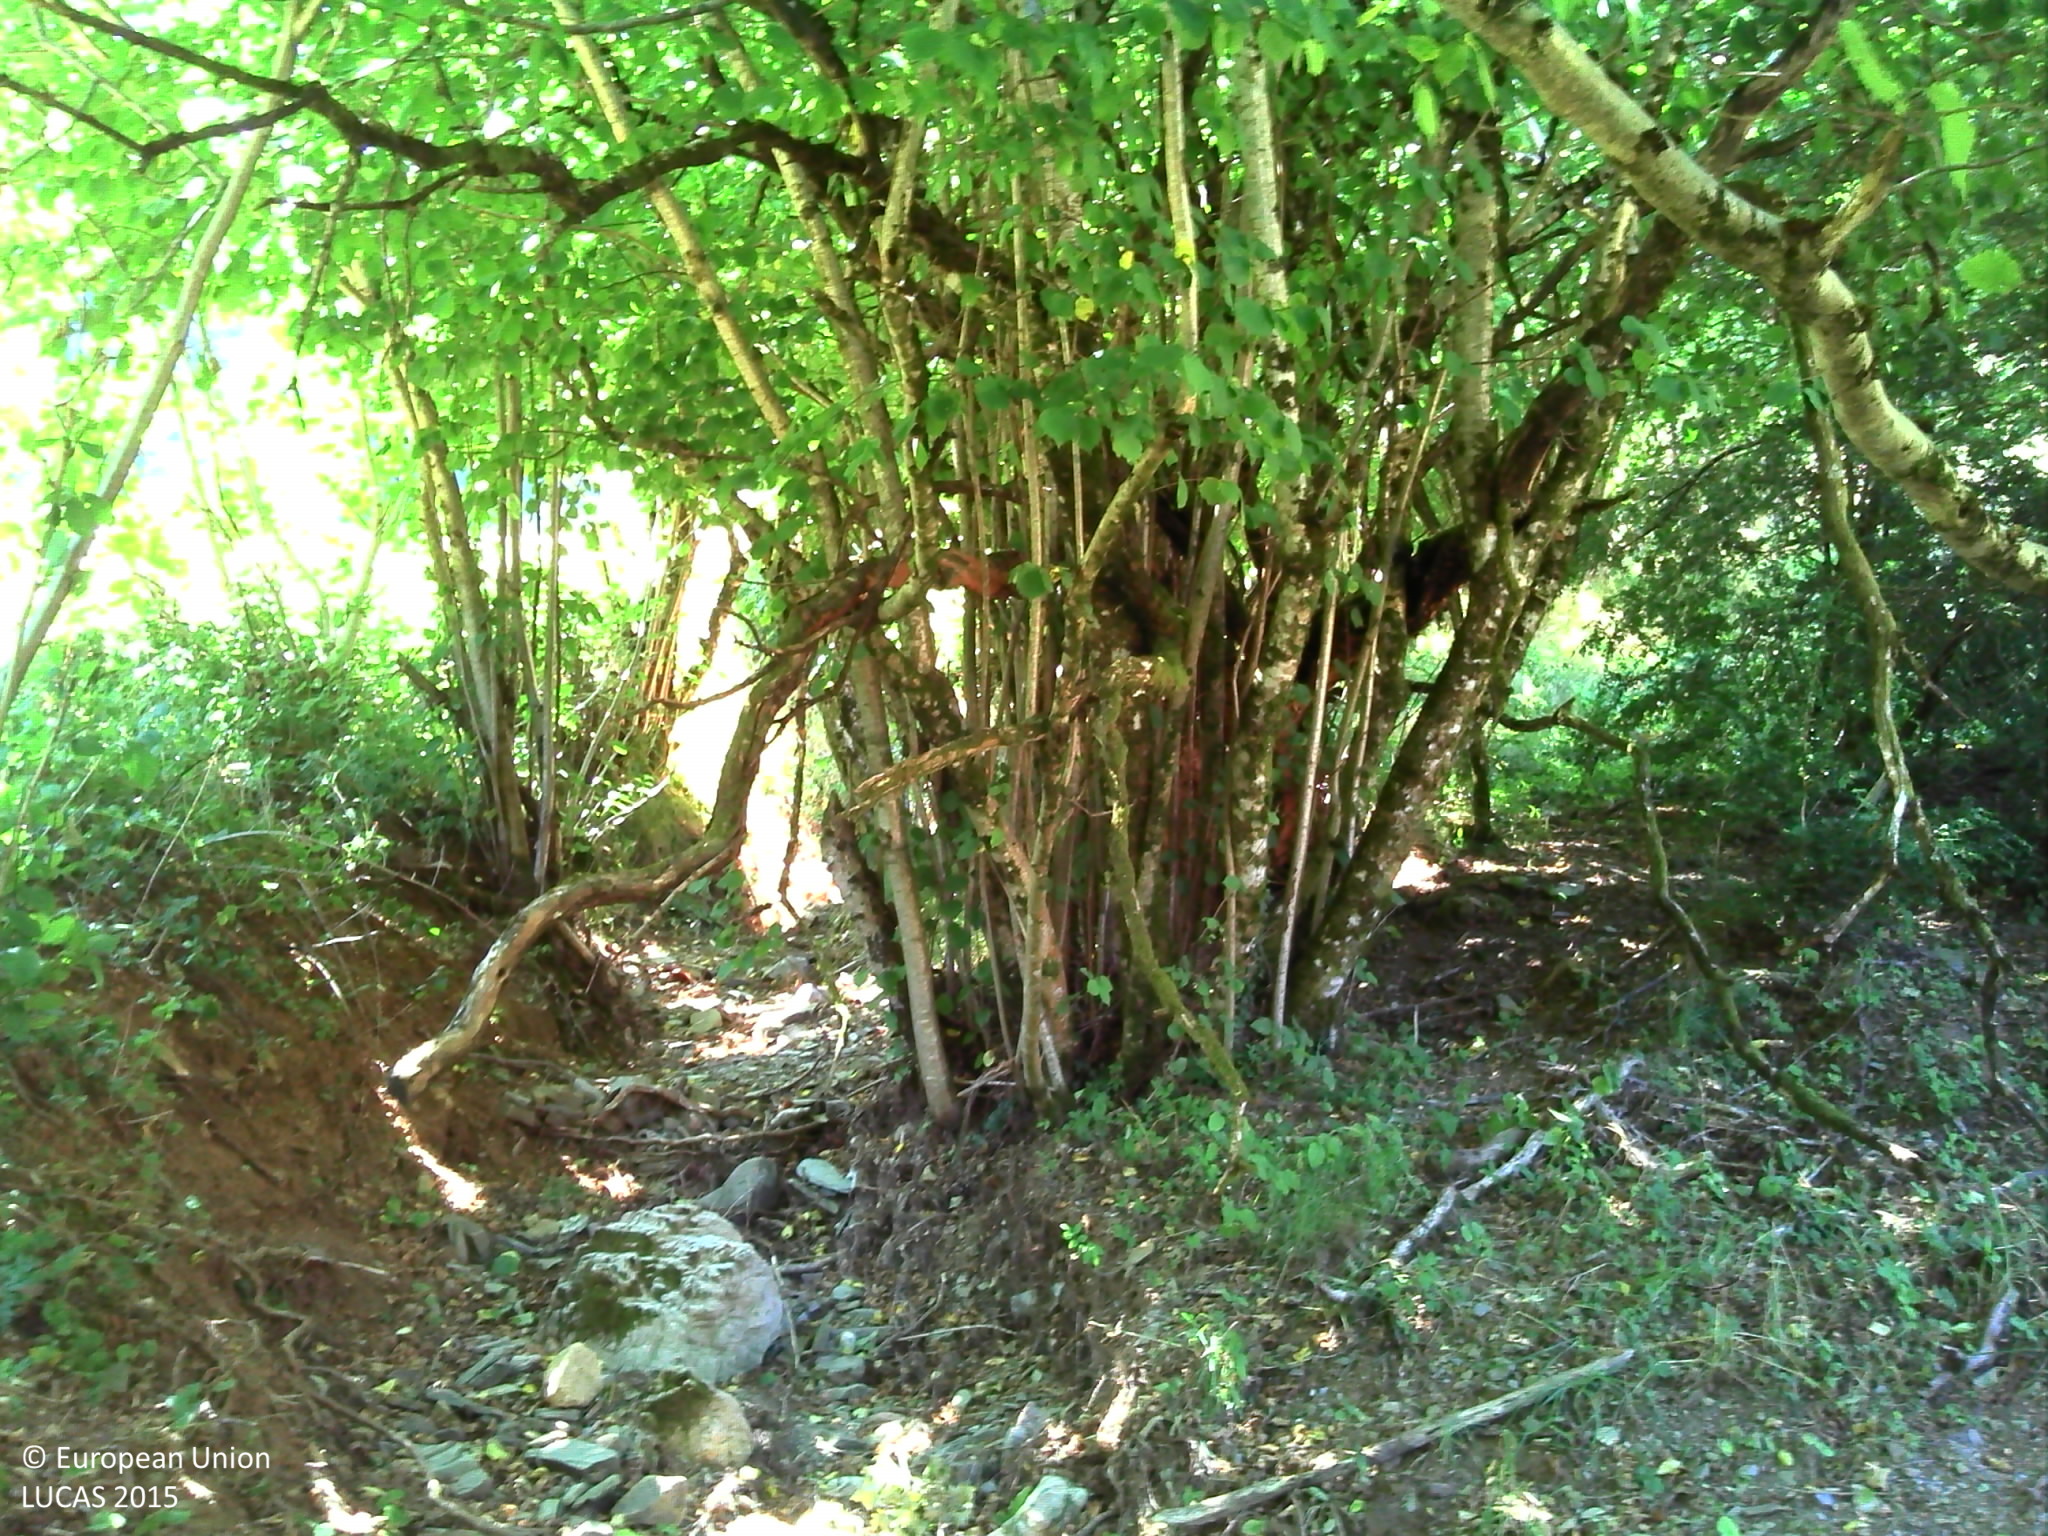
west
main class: Cropland
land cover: Temporary grasslands
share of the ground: > 75 %
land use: Agriculture (excluding fallow land and kitchen gardens)
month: August
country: FR
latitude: 43.7188
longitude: 3.0441
